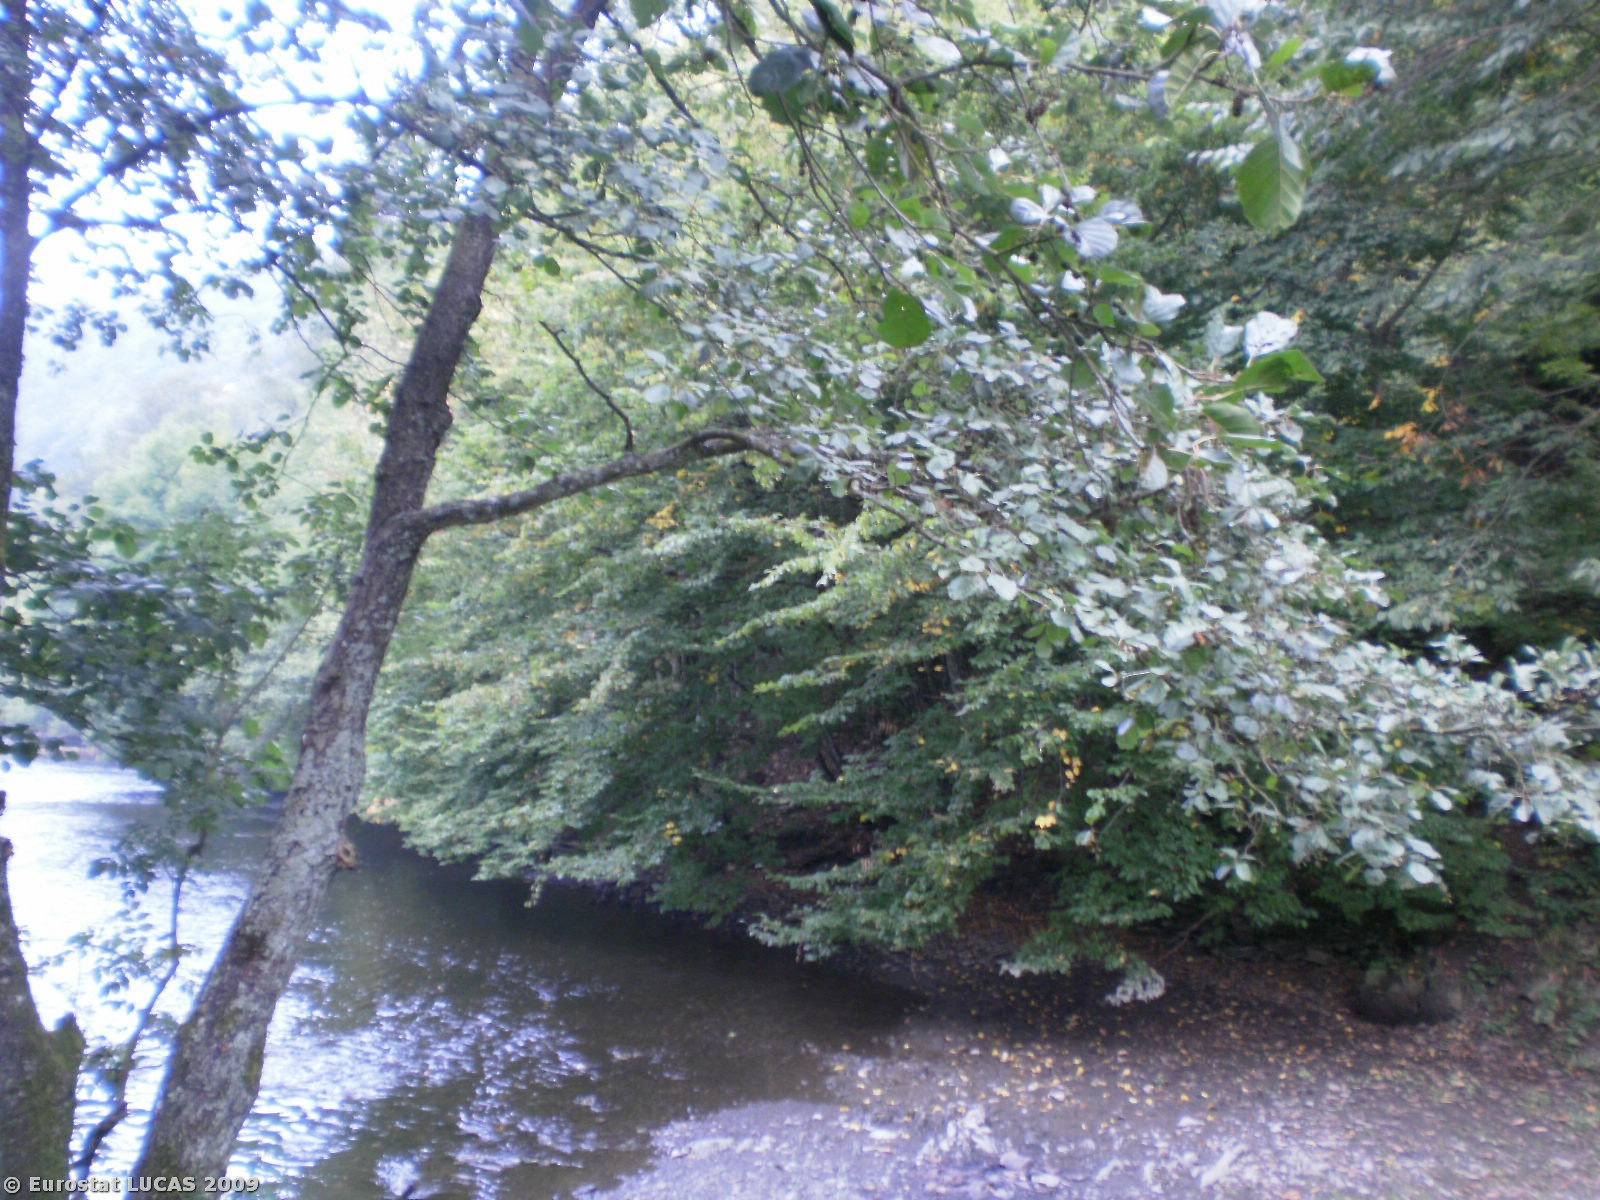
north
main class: Woodland
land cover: Broadleaved woodland
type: mountainous beech forest
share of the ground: > 75 %
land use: Forestry
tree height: > 5 m
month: September
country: BE
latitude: 50.1720
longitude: 5.6161
